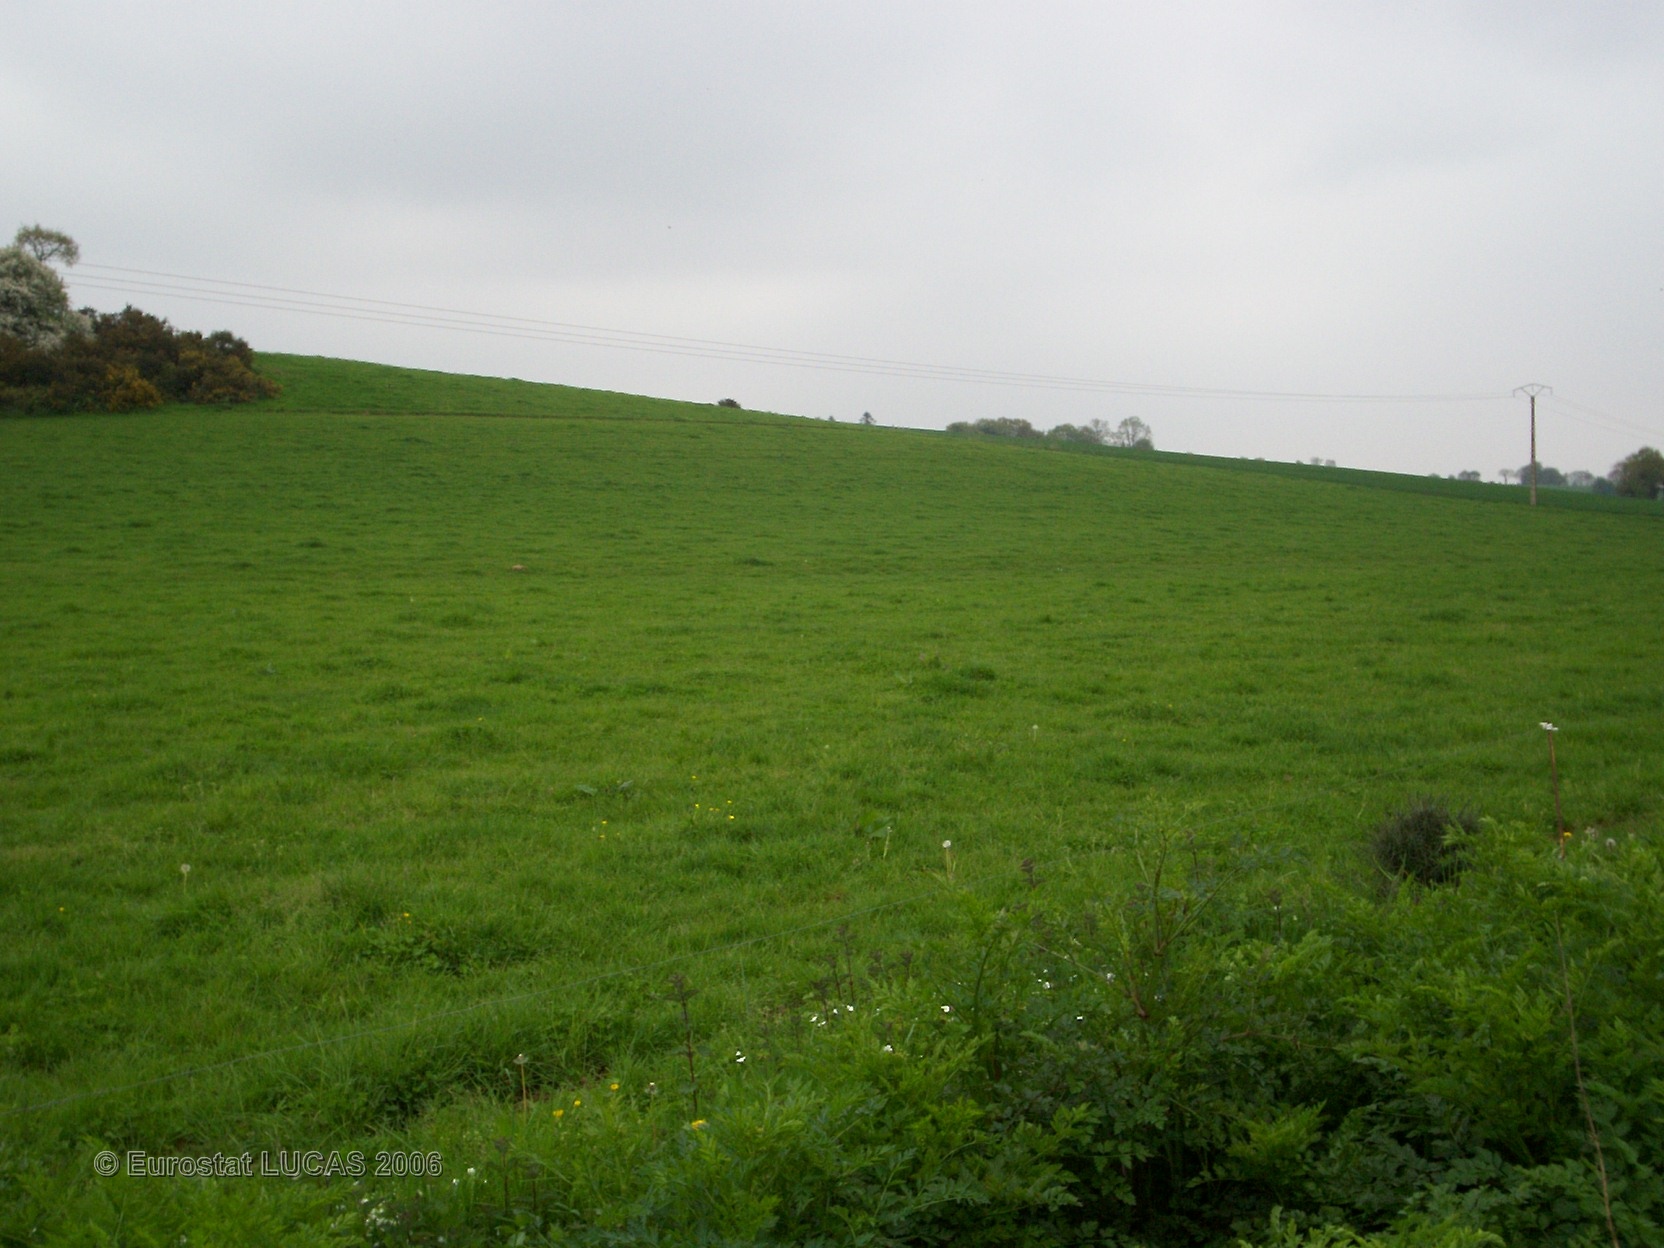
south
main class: Grassland
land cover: Grassland without tree/shrub cover
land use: Agriculture (excluding fallow land and kitchen gardens)
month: May
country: FR
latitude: 48.2067
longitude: -2.9181
